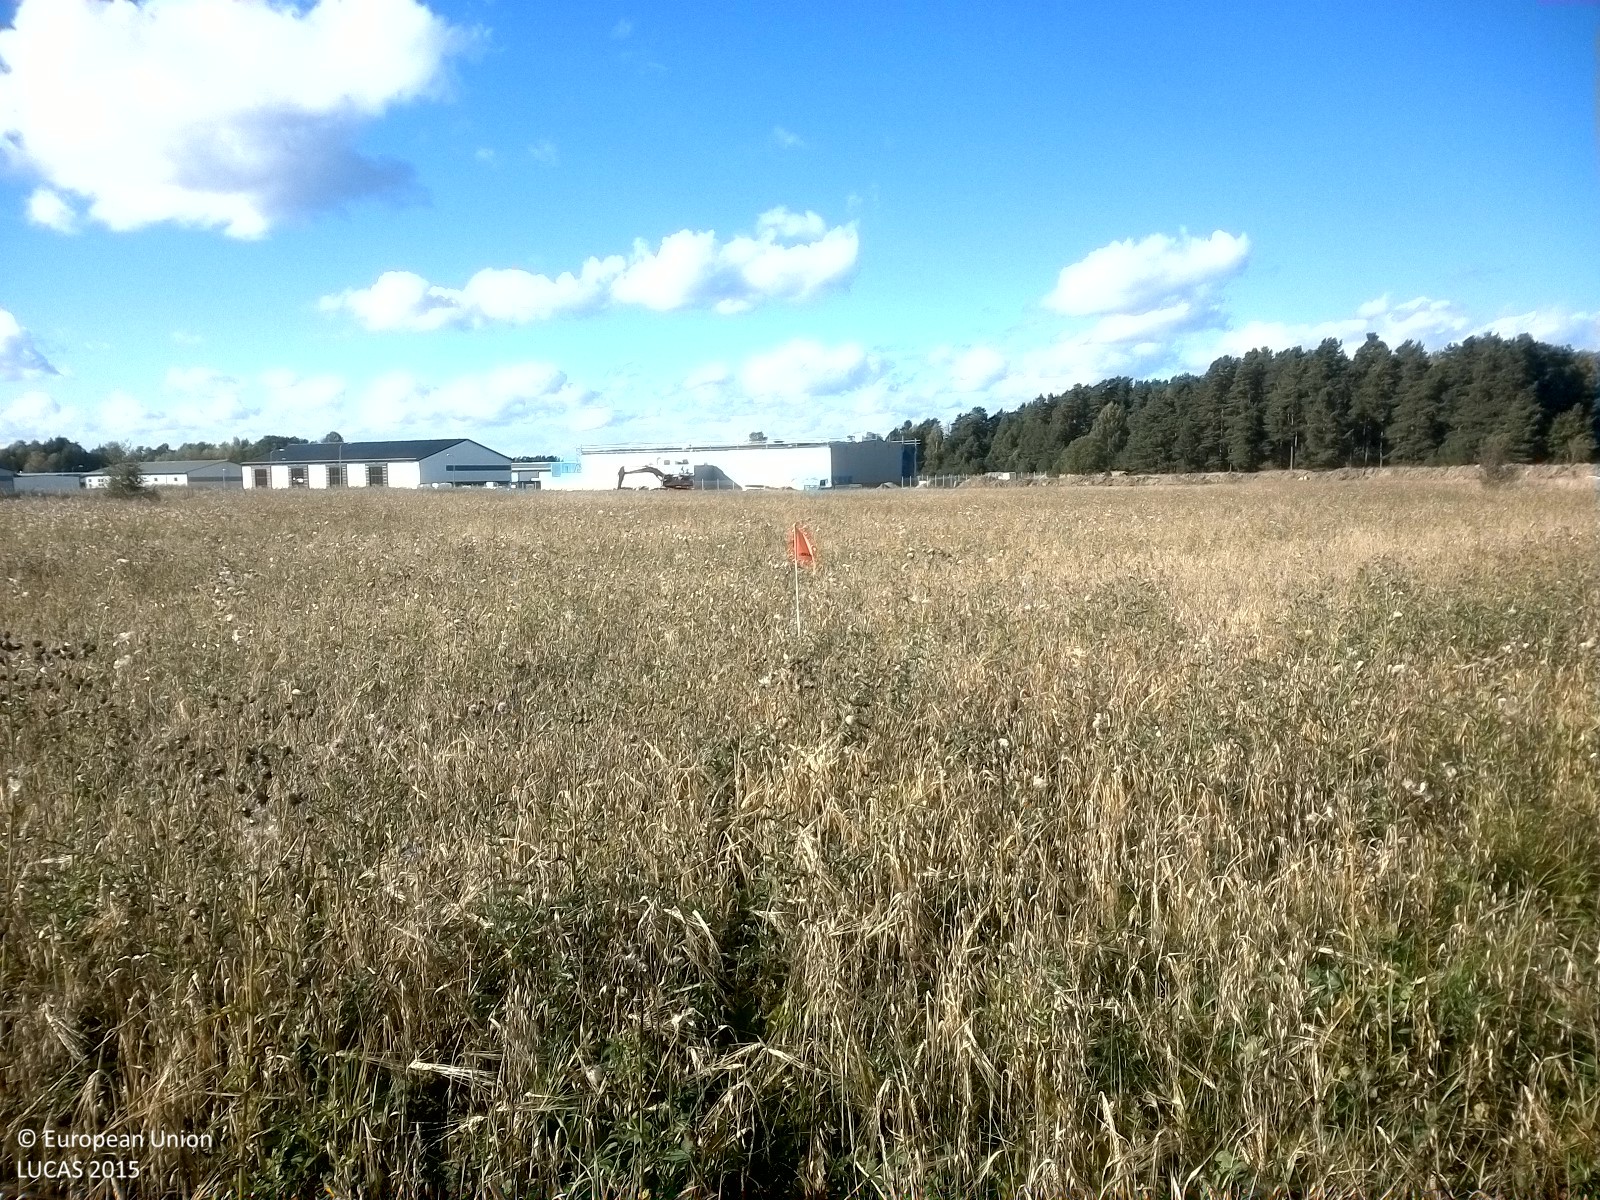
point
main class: Grassland
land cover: Spontaneously vegetated surfaces
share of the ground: > 75 %
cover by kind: herbaceous plants 100 %
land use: Agriculture (excluding fallow land and kitchen gardens)
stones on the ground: < 10 %
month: September
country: SE
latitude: 58.4235
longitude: 15.6963
